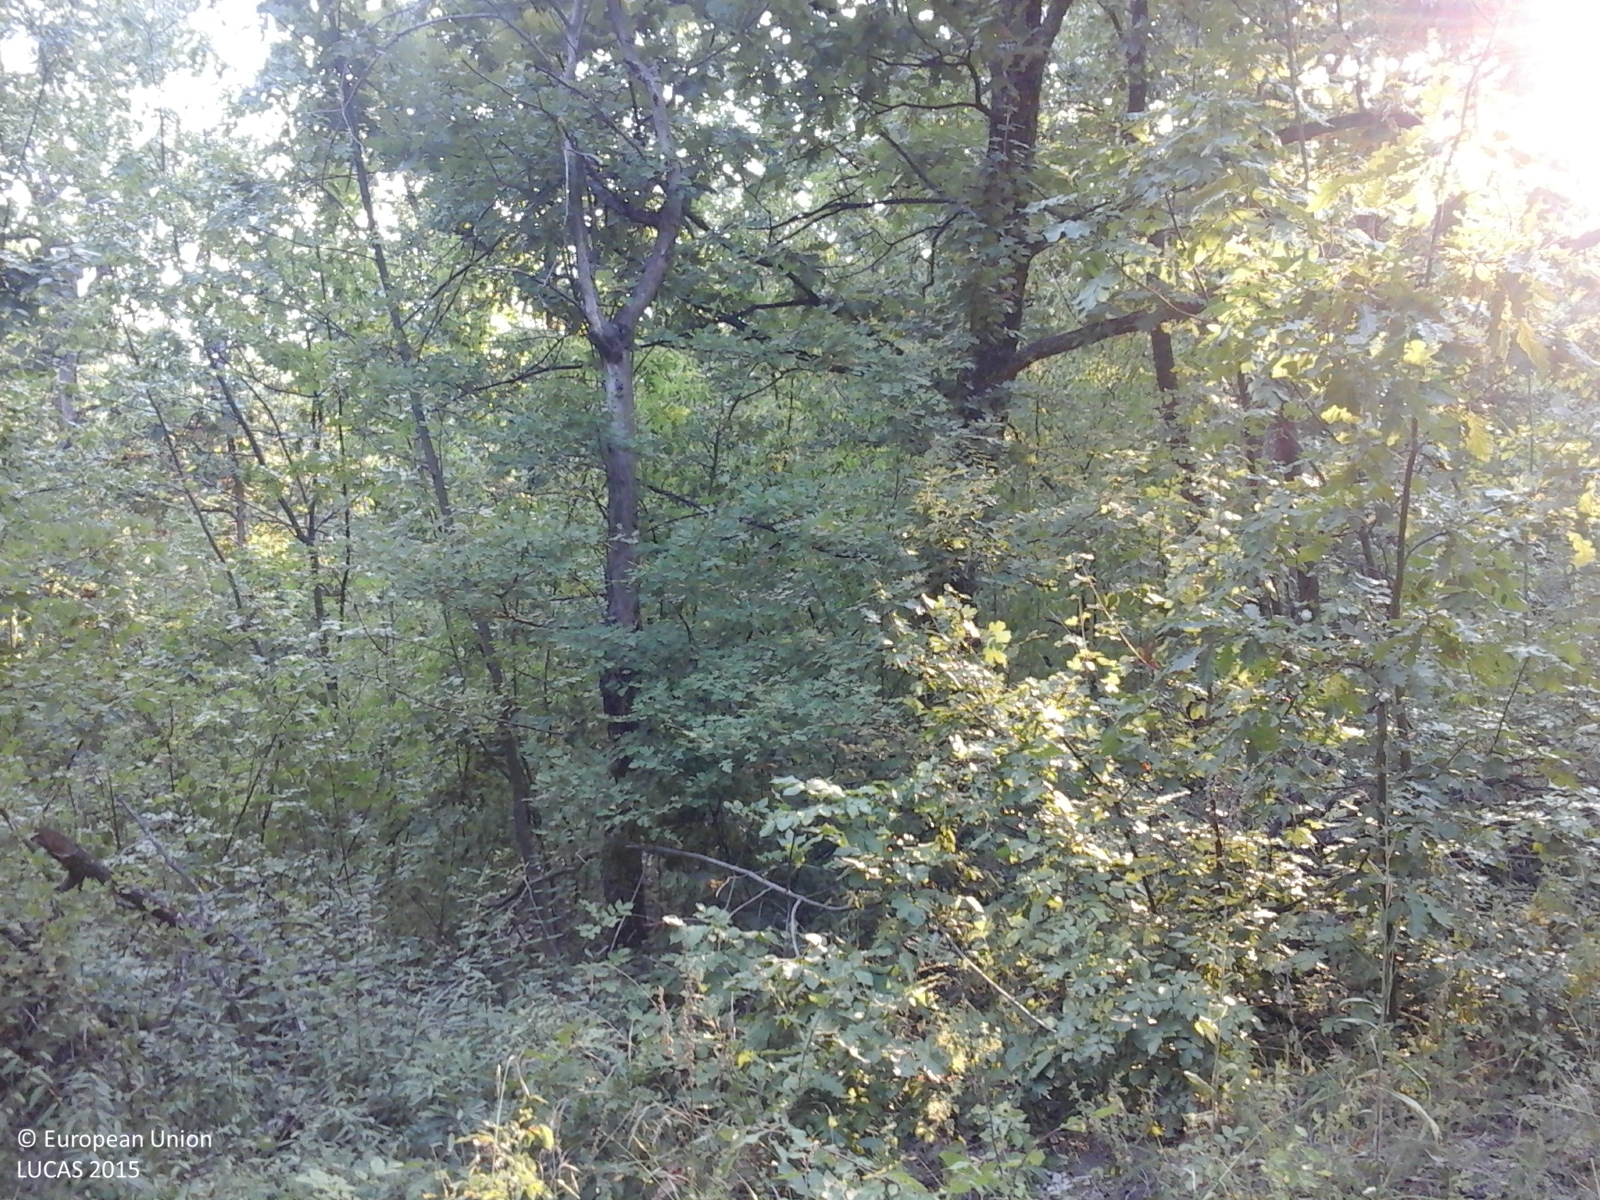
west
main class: Woodland
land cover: Broadleaved woodland
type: acidophilous oak and oak-birch forest
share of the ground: > 75 %
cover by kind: broadleaved forest trees 100 %
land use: Forestry
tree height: > 5 m
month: August
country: RO
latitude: 44.5788
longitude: 23.2100
